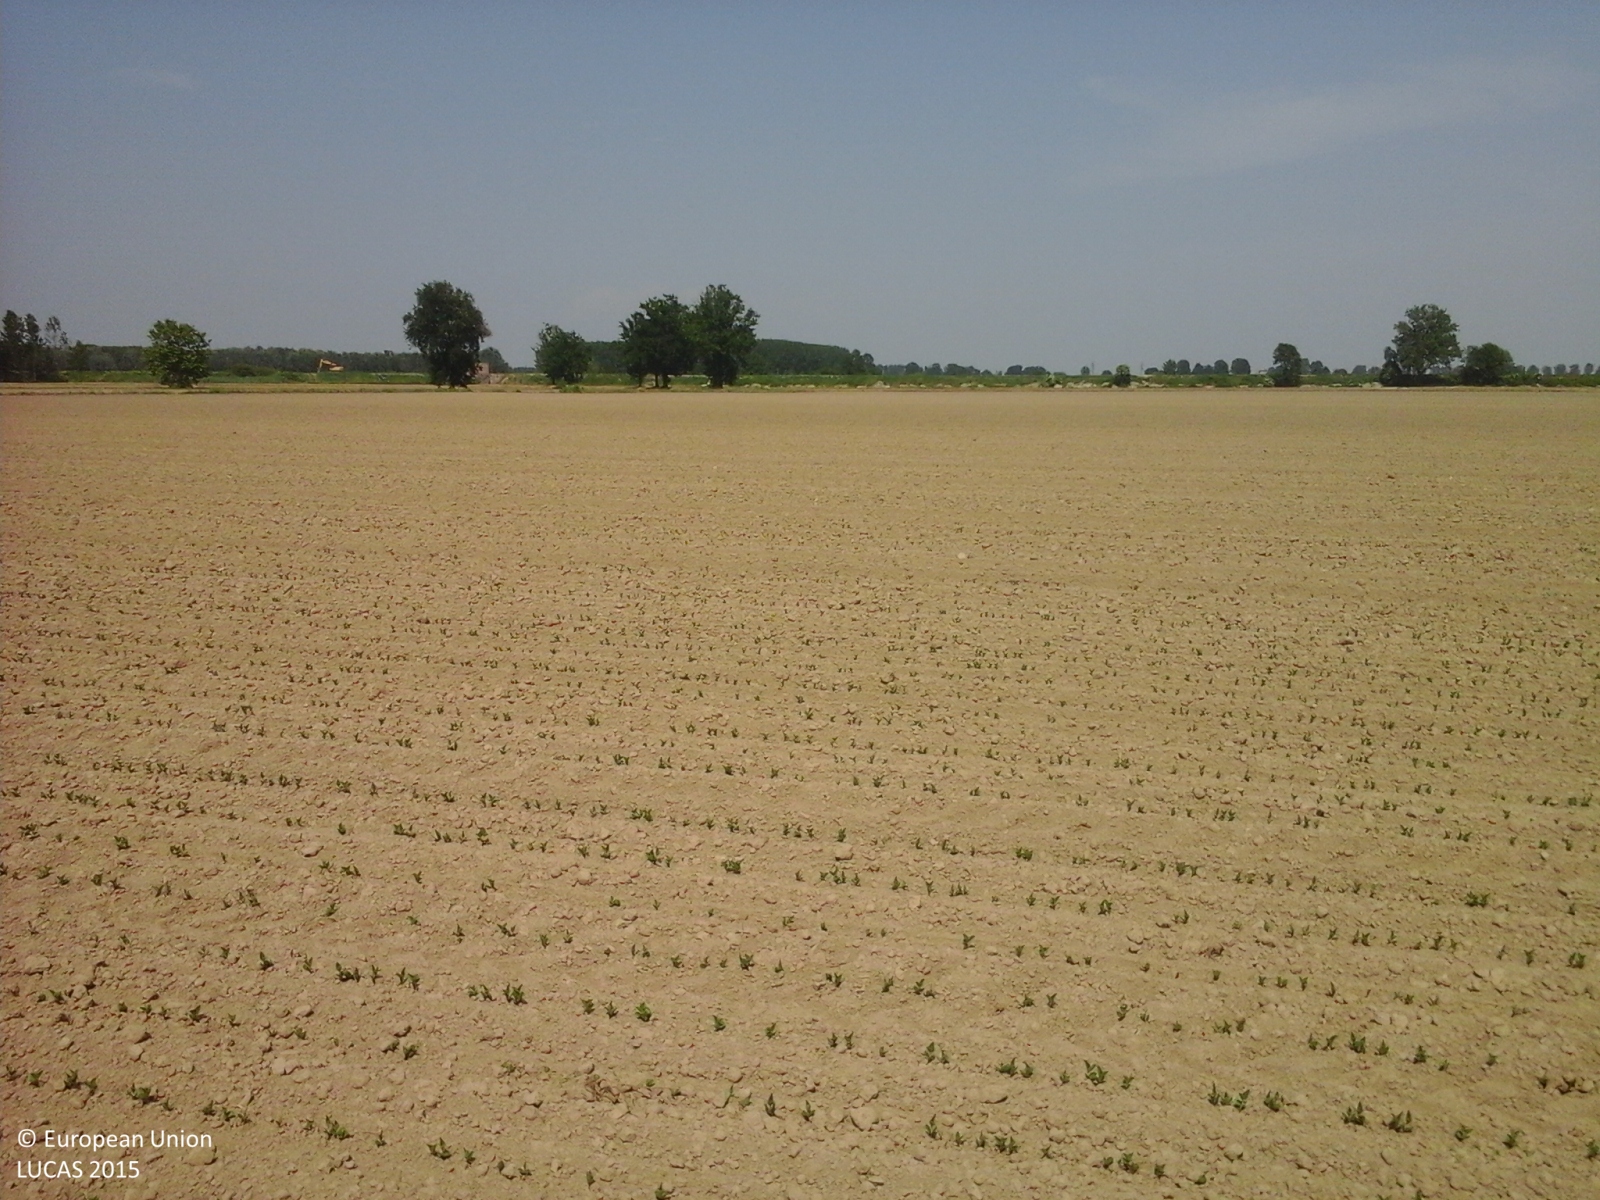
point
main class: Cropland
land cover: Soya
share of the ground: < 10 %
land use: Agriculture (excluding fallow land and kitchen gardens)
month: May
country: IT
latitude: 45.2142
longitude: 9.3772
